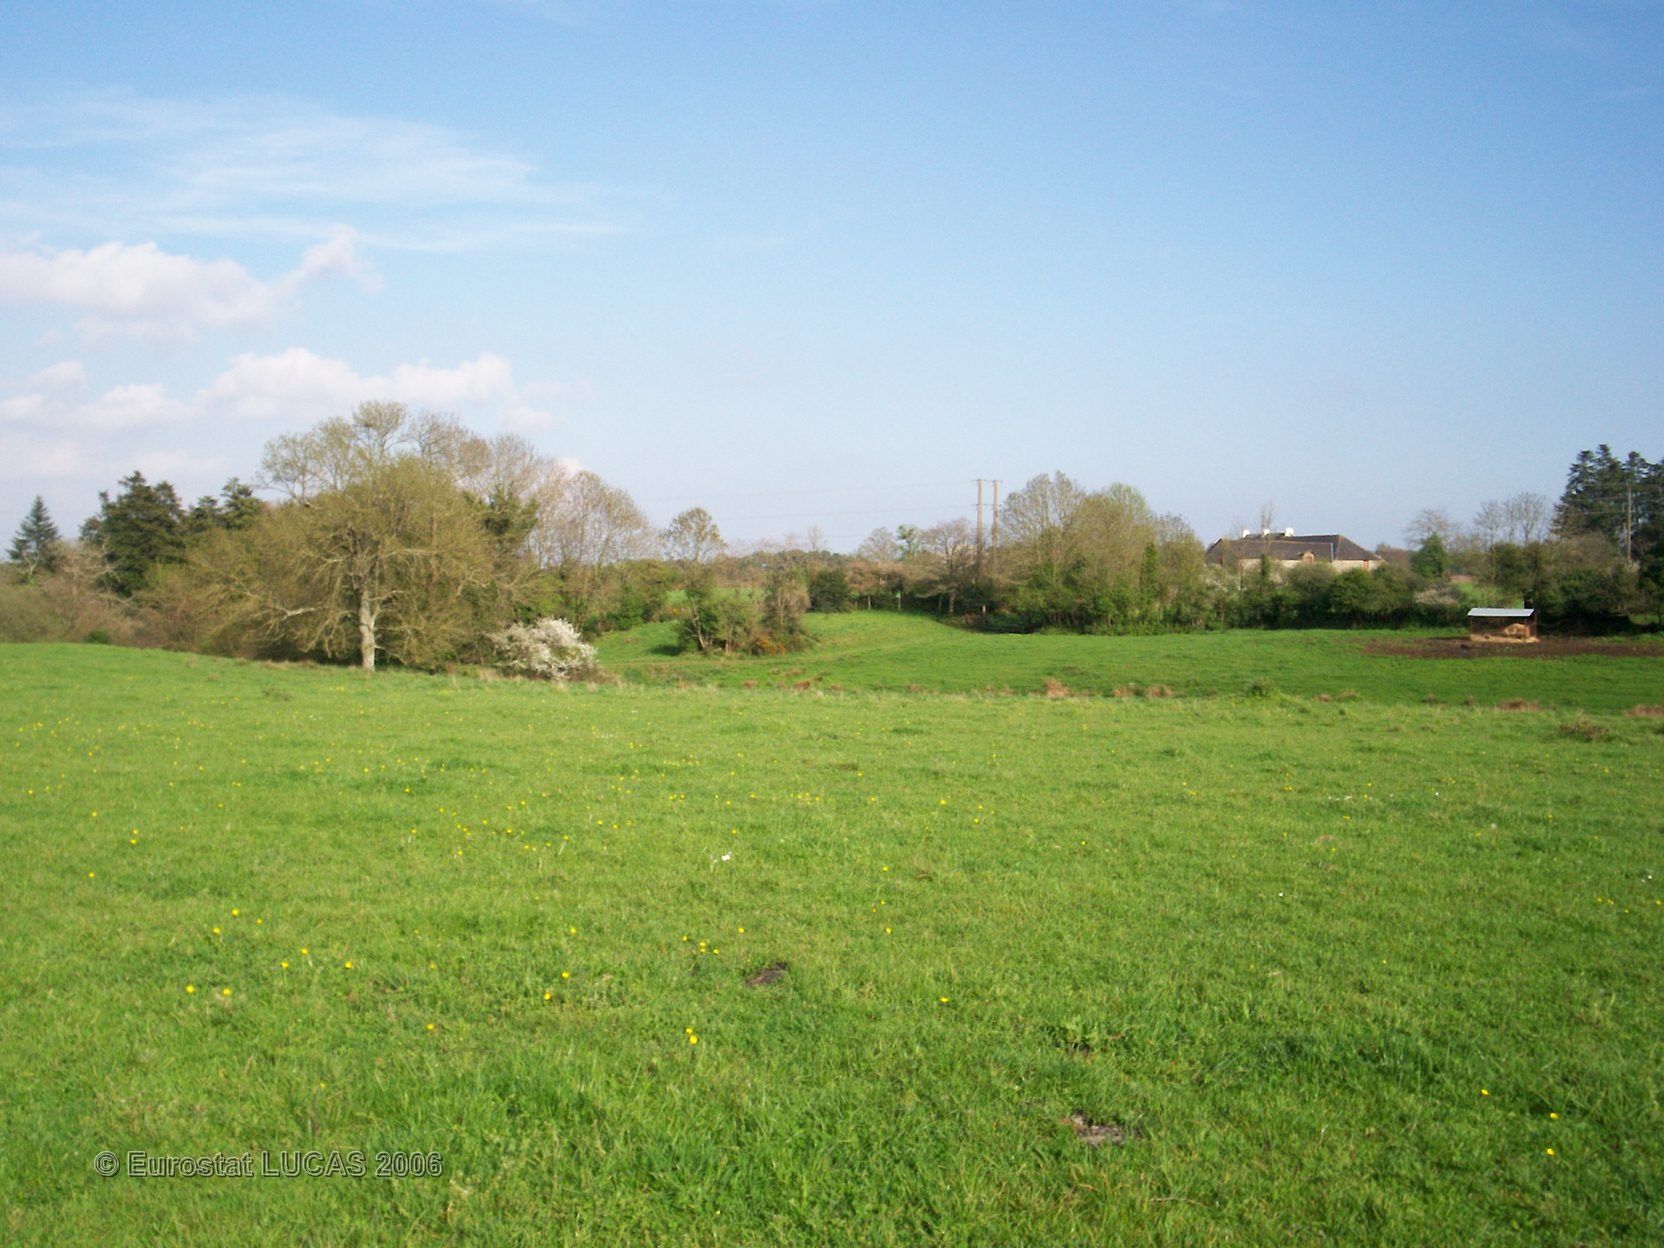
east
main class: Grassland
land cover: Grassland without tree/shrub cover
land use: Agriculture (excluding fallow land and kitchen gardens)
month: April
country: FR
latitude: 47.6522
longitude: -2.8308
